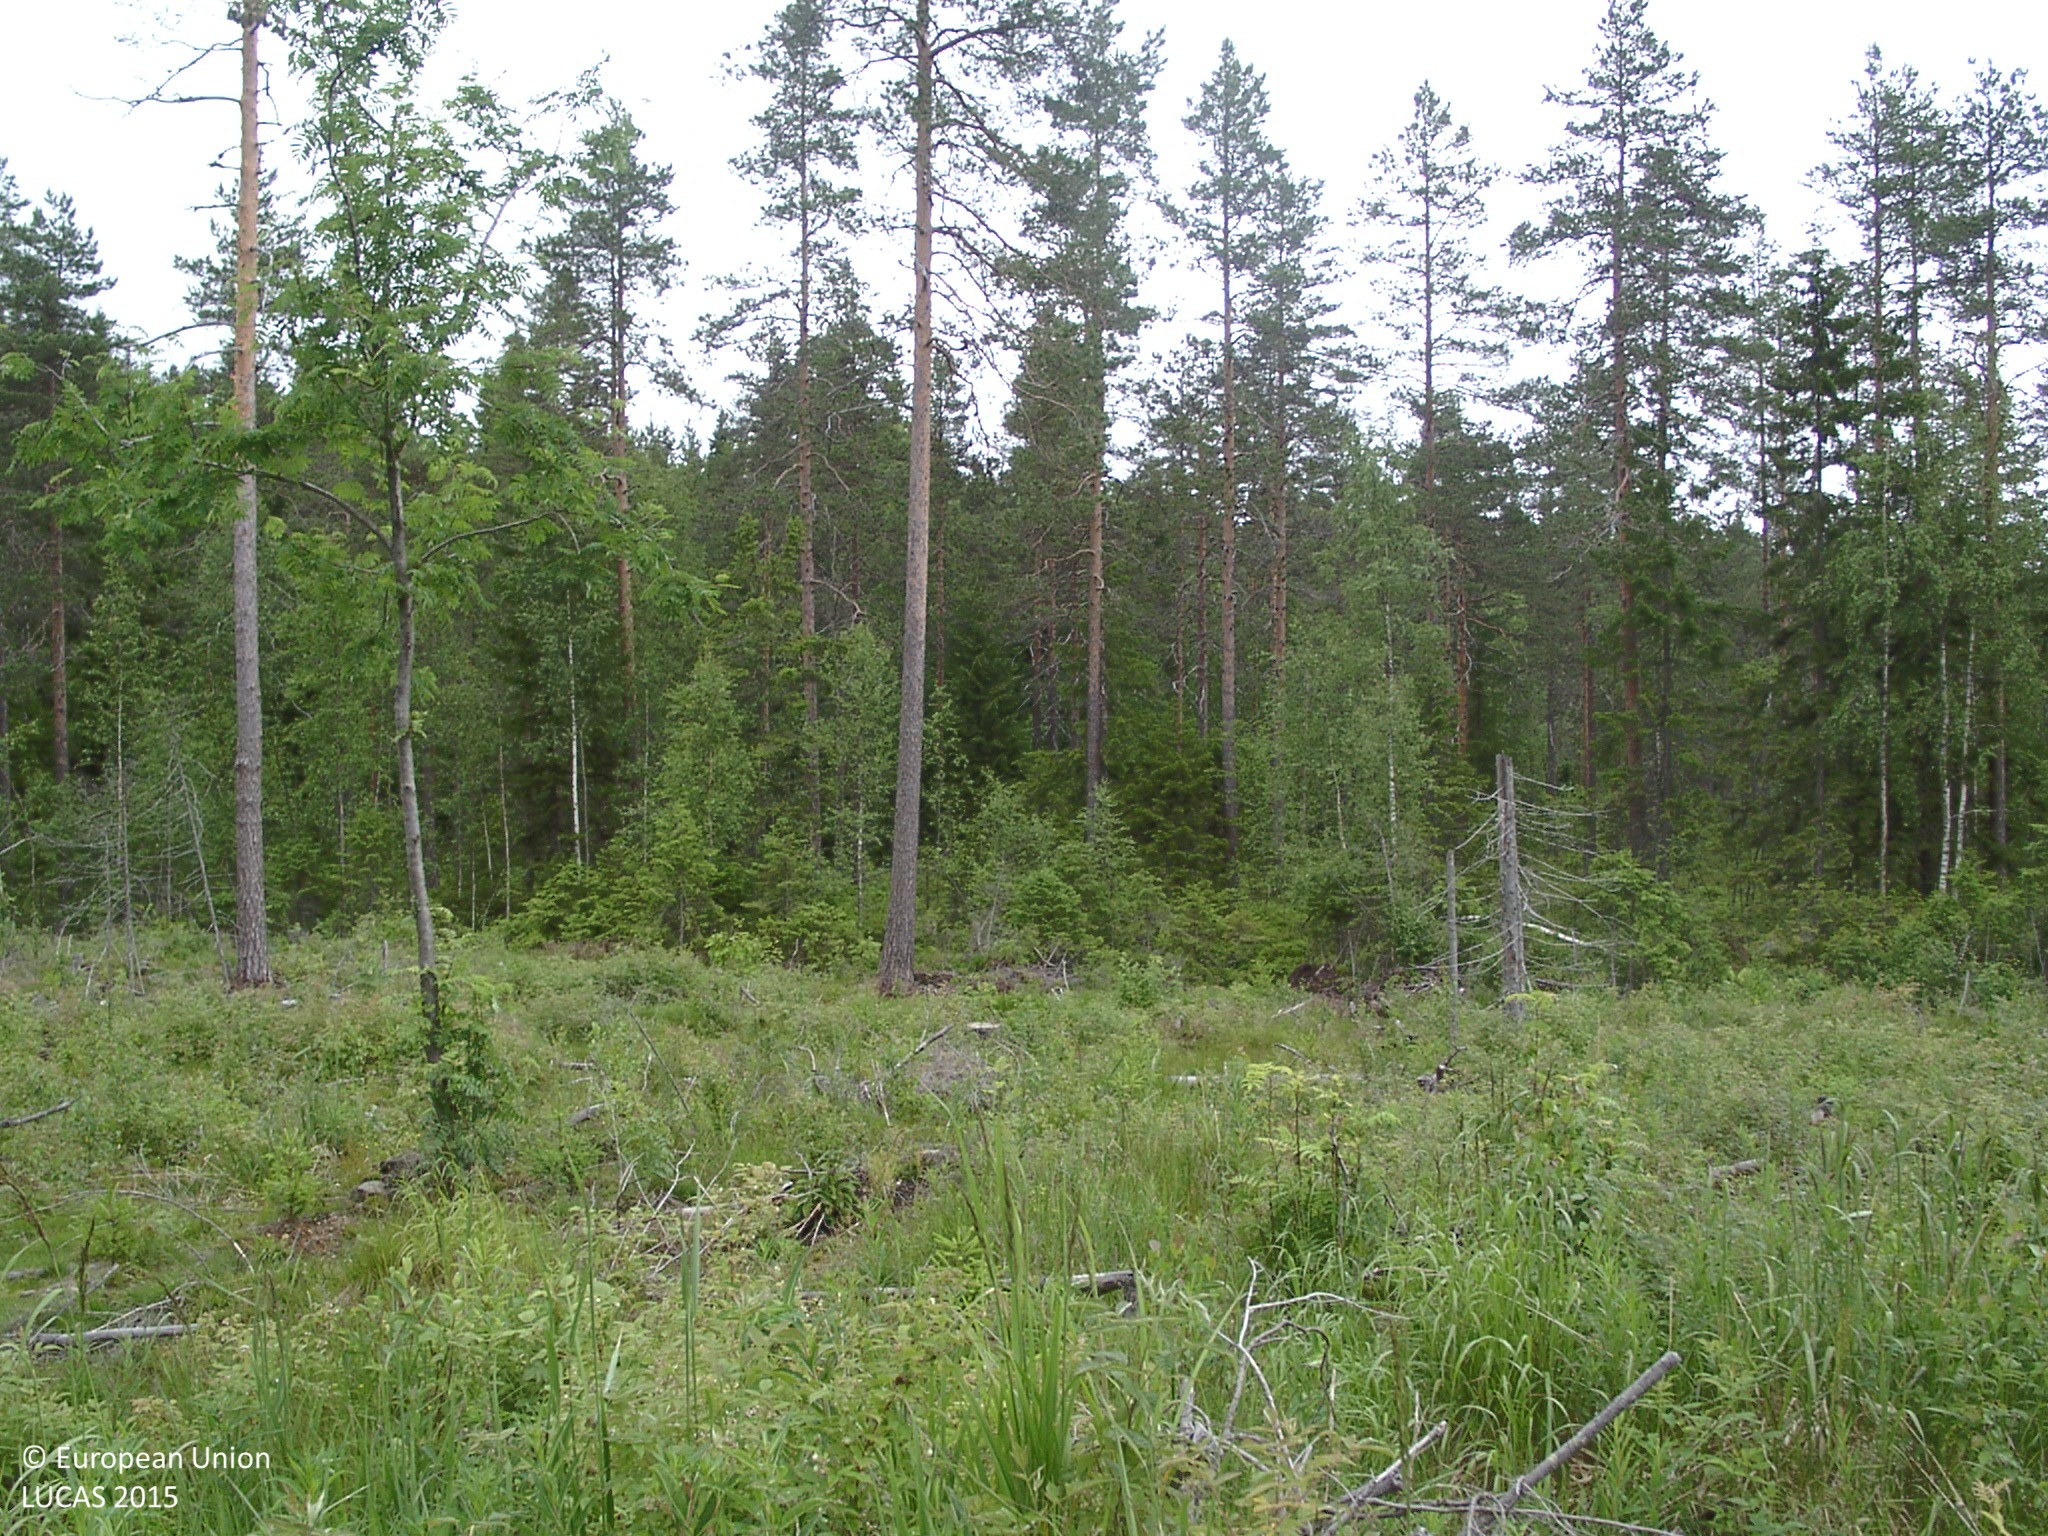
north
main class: Shrubland
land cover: Shrubland with sparse tree cover
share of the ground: 25 - 50 %
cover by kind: herbaceous plants 60 %, shrubs 30 %, broadleaved forest trees 5 %
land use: Forestry
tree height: < 5 m
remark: Nursery
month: July
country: FI
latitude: 62.0841
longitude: 25.4510
